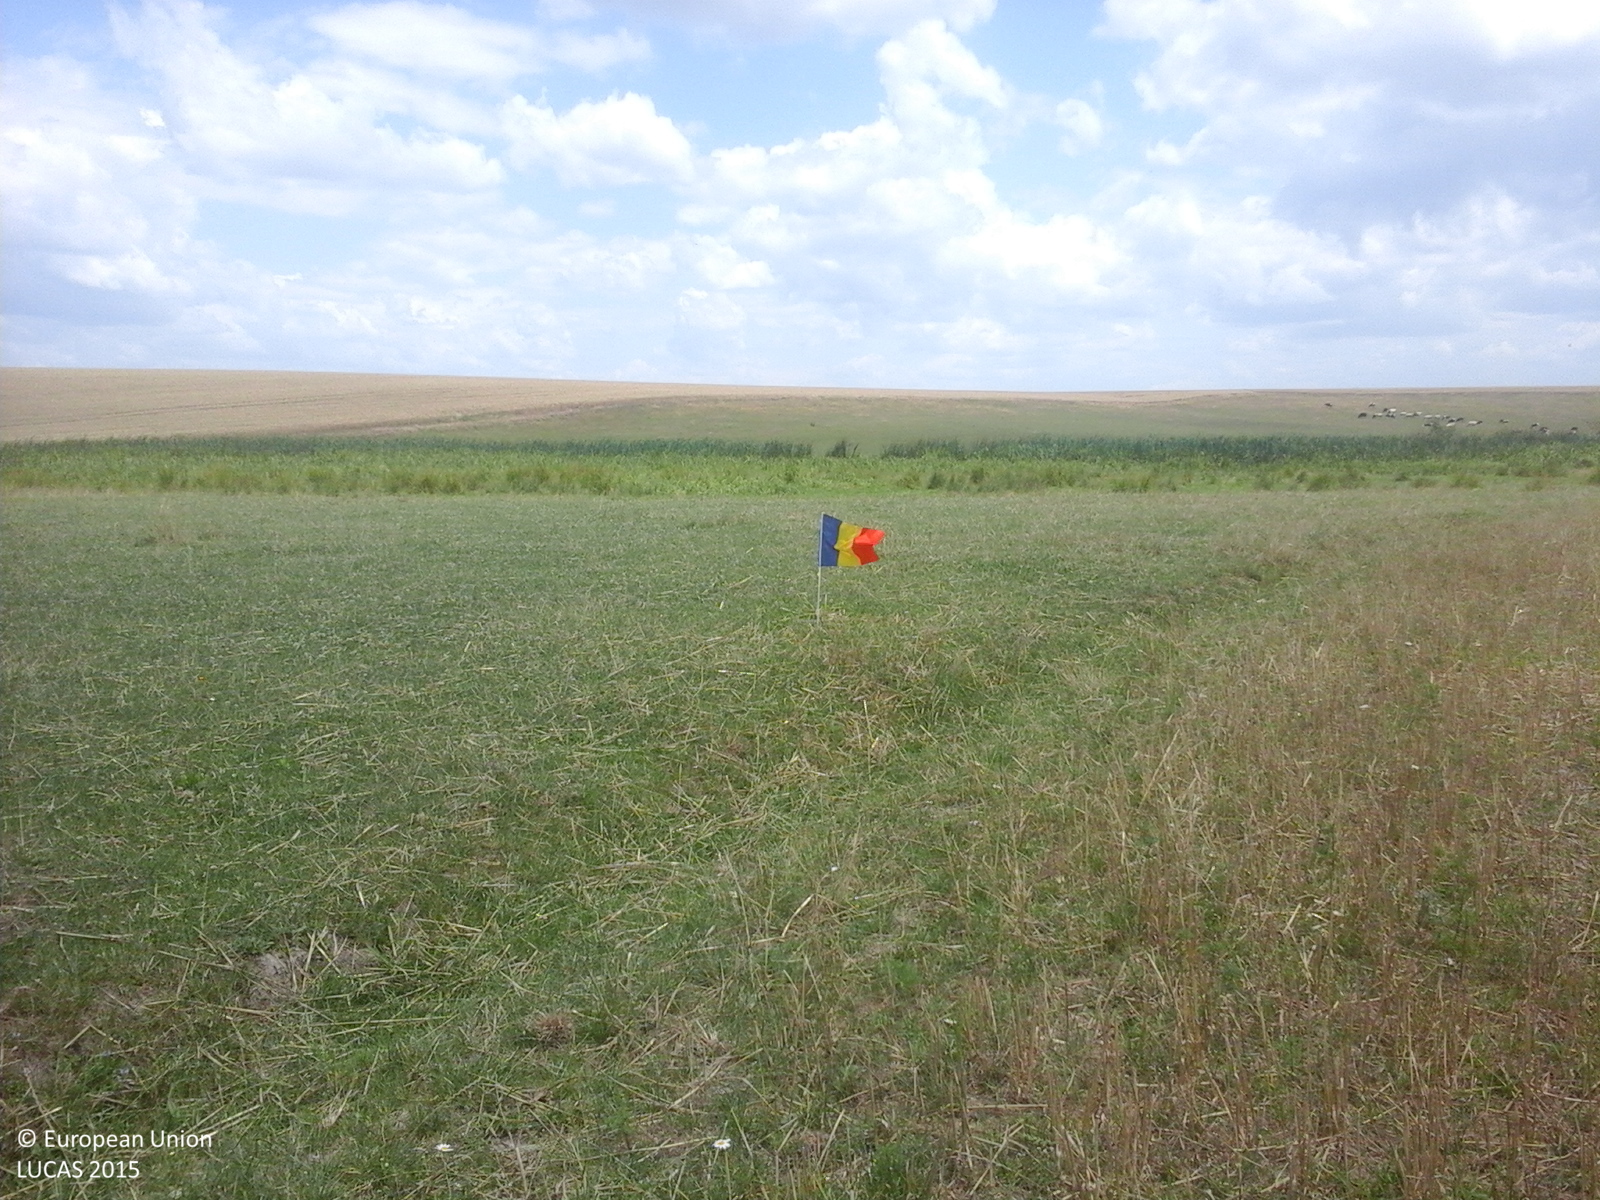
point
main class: Grassland
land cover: Grassland without tree/shrub cover
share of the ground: > 75 %
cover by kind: herbaceous plants 100 %
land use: Agriculture (excluding fallow land and kitchen gardens)
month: July
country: RO
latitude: 44.3069
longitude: 24.9326
